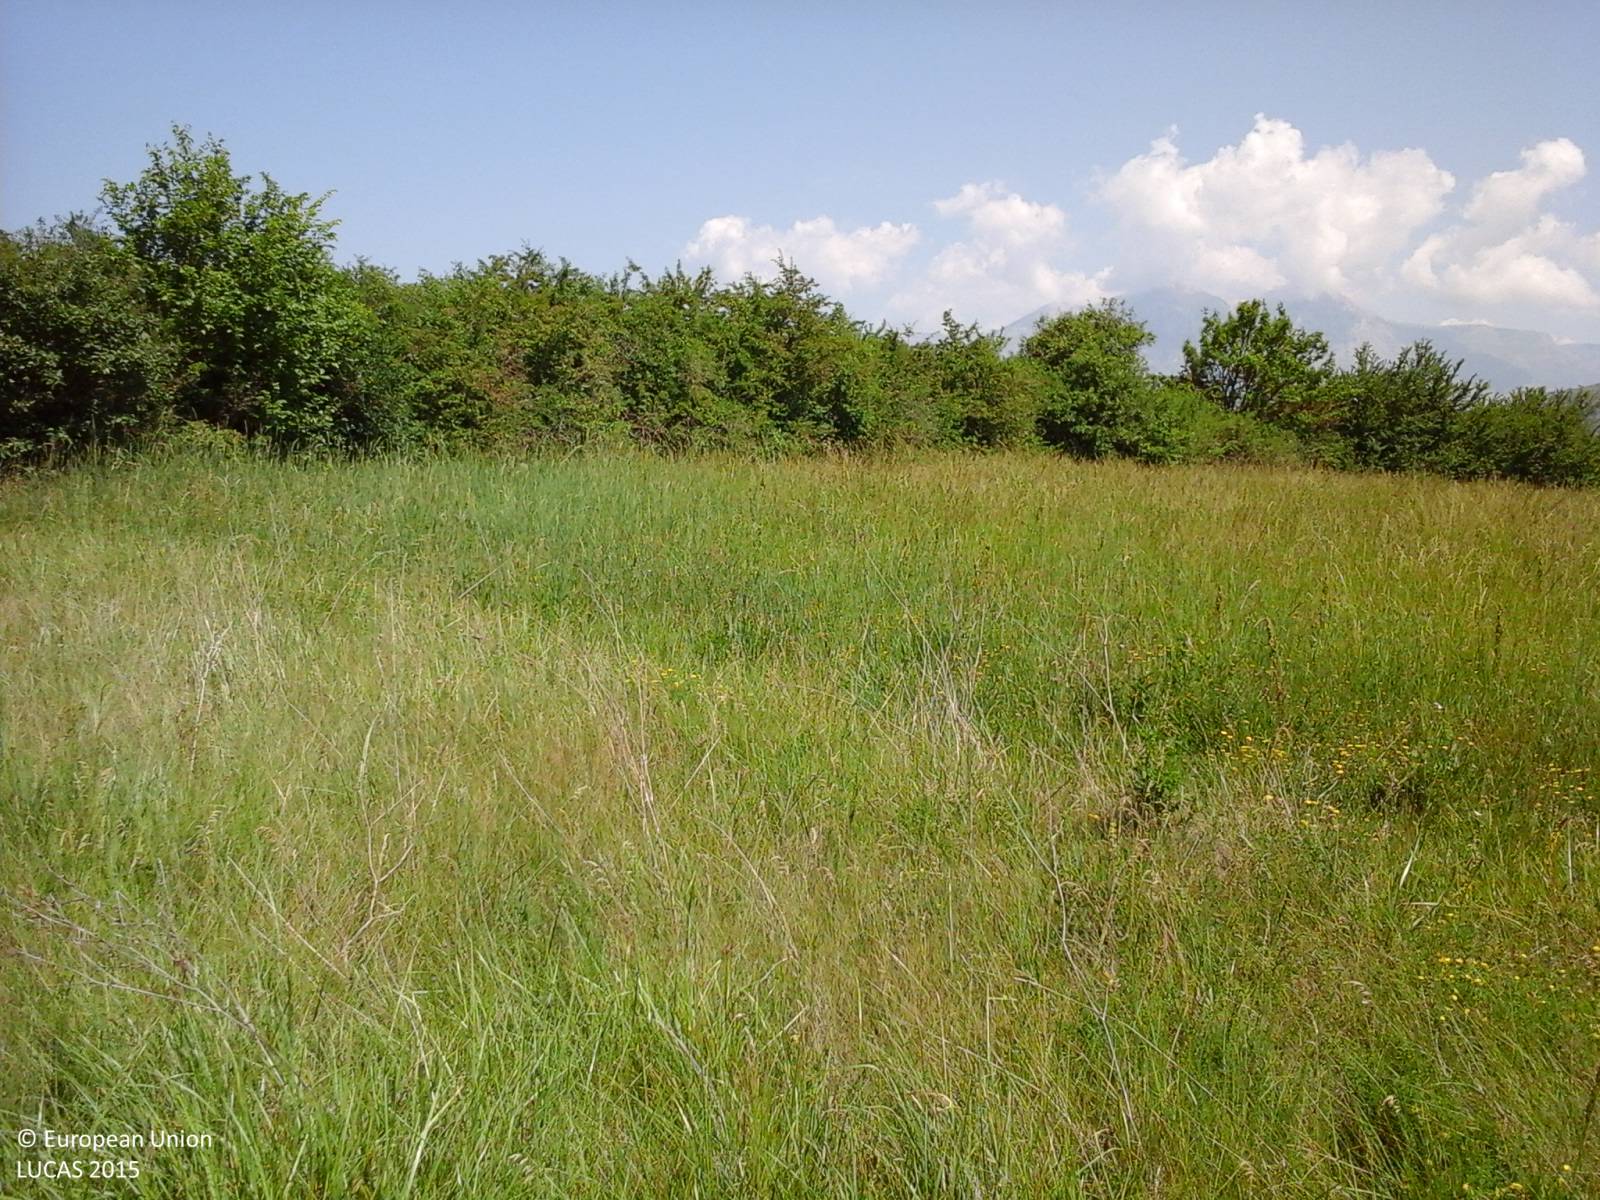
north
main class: Grassland
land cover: Grassland without tree/shrub cover
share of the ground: > 75 %
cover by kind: herbaceous plants 100 %
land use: Agriculture (excluding fallow land and kitchen gardens)
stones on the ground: < 10 %
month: June
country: IT
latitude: 42.0198
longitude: 13.3577
